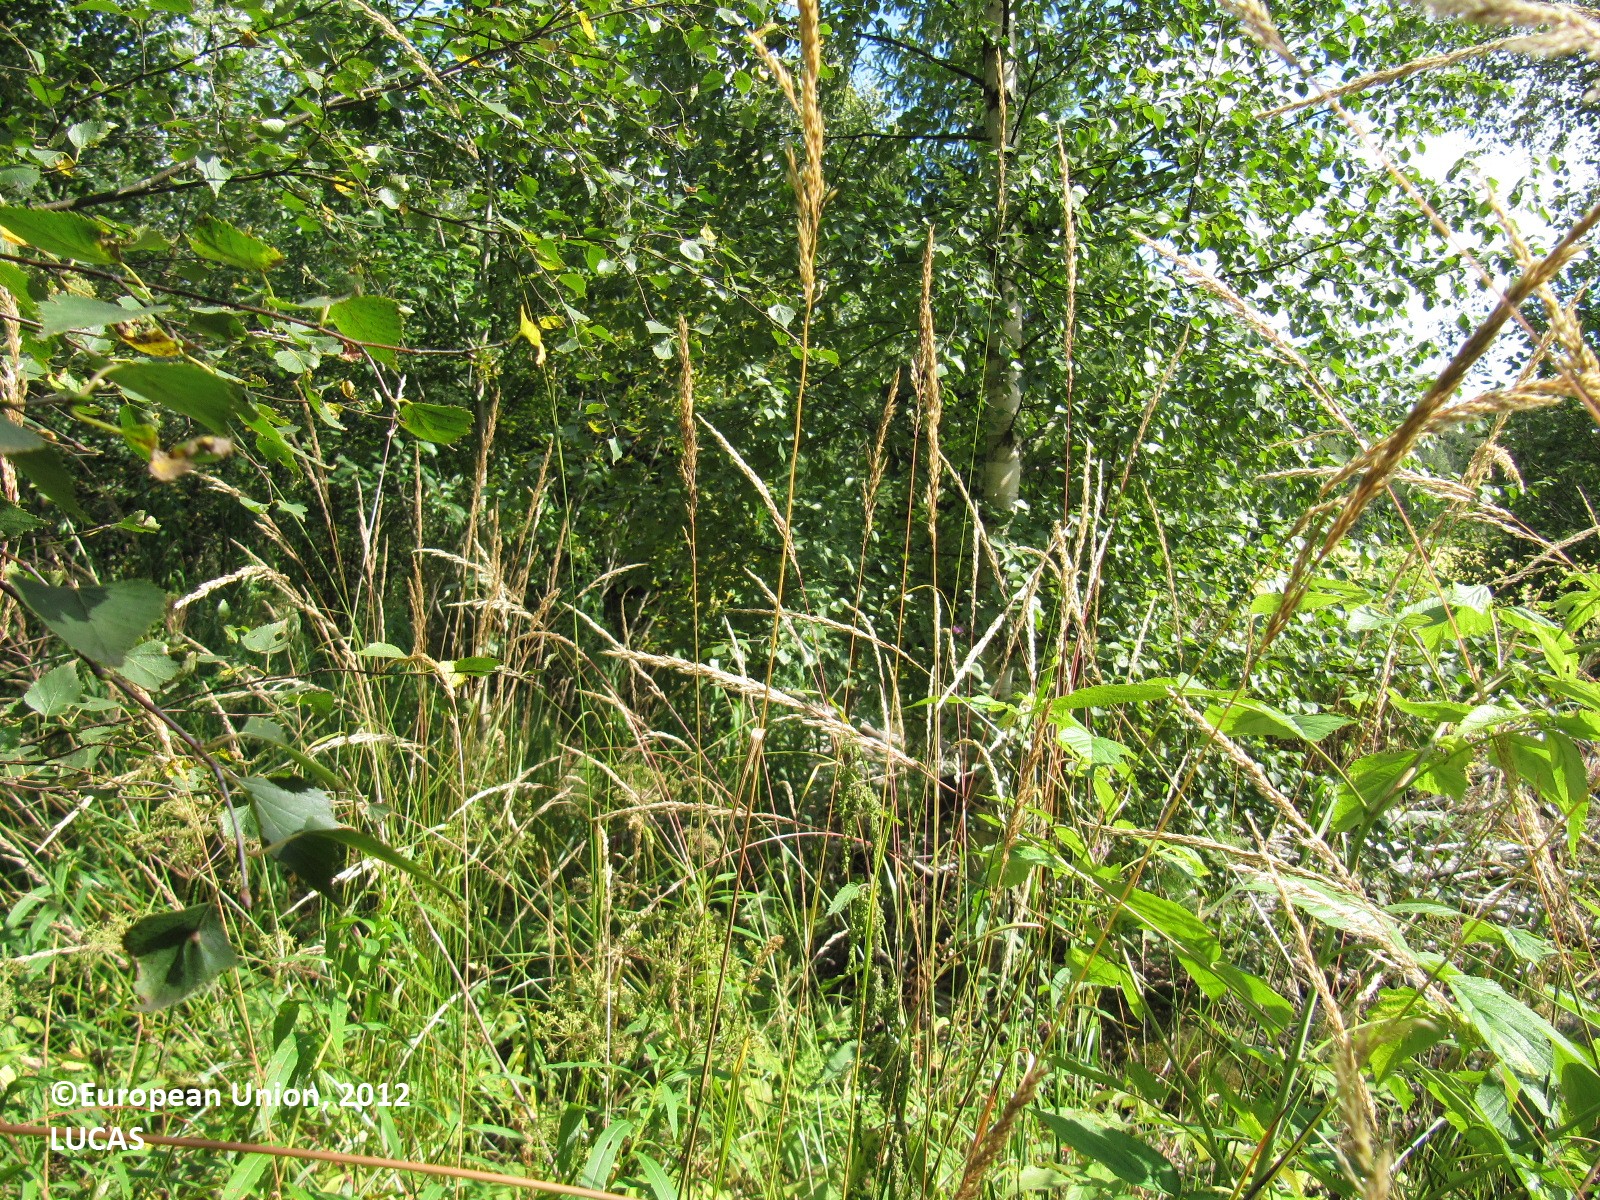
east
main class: Woodland
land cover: Broadleaved woodland
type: boreal forest
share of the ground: 50 - 75 %
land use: Forestry
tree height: > 5 m
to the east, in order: Broadleaved woodland; Ditches and canals; Spontaneously vegetated surfaces; Barley; Electric lines; Barley; Spontaneously vegetated surfaces; Ditches and canals; Broadleaved woodland
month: August
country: FI
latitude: 60.4373
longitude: 24.4791
